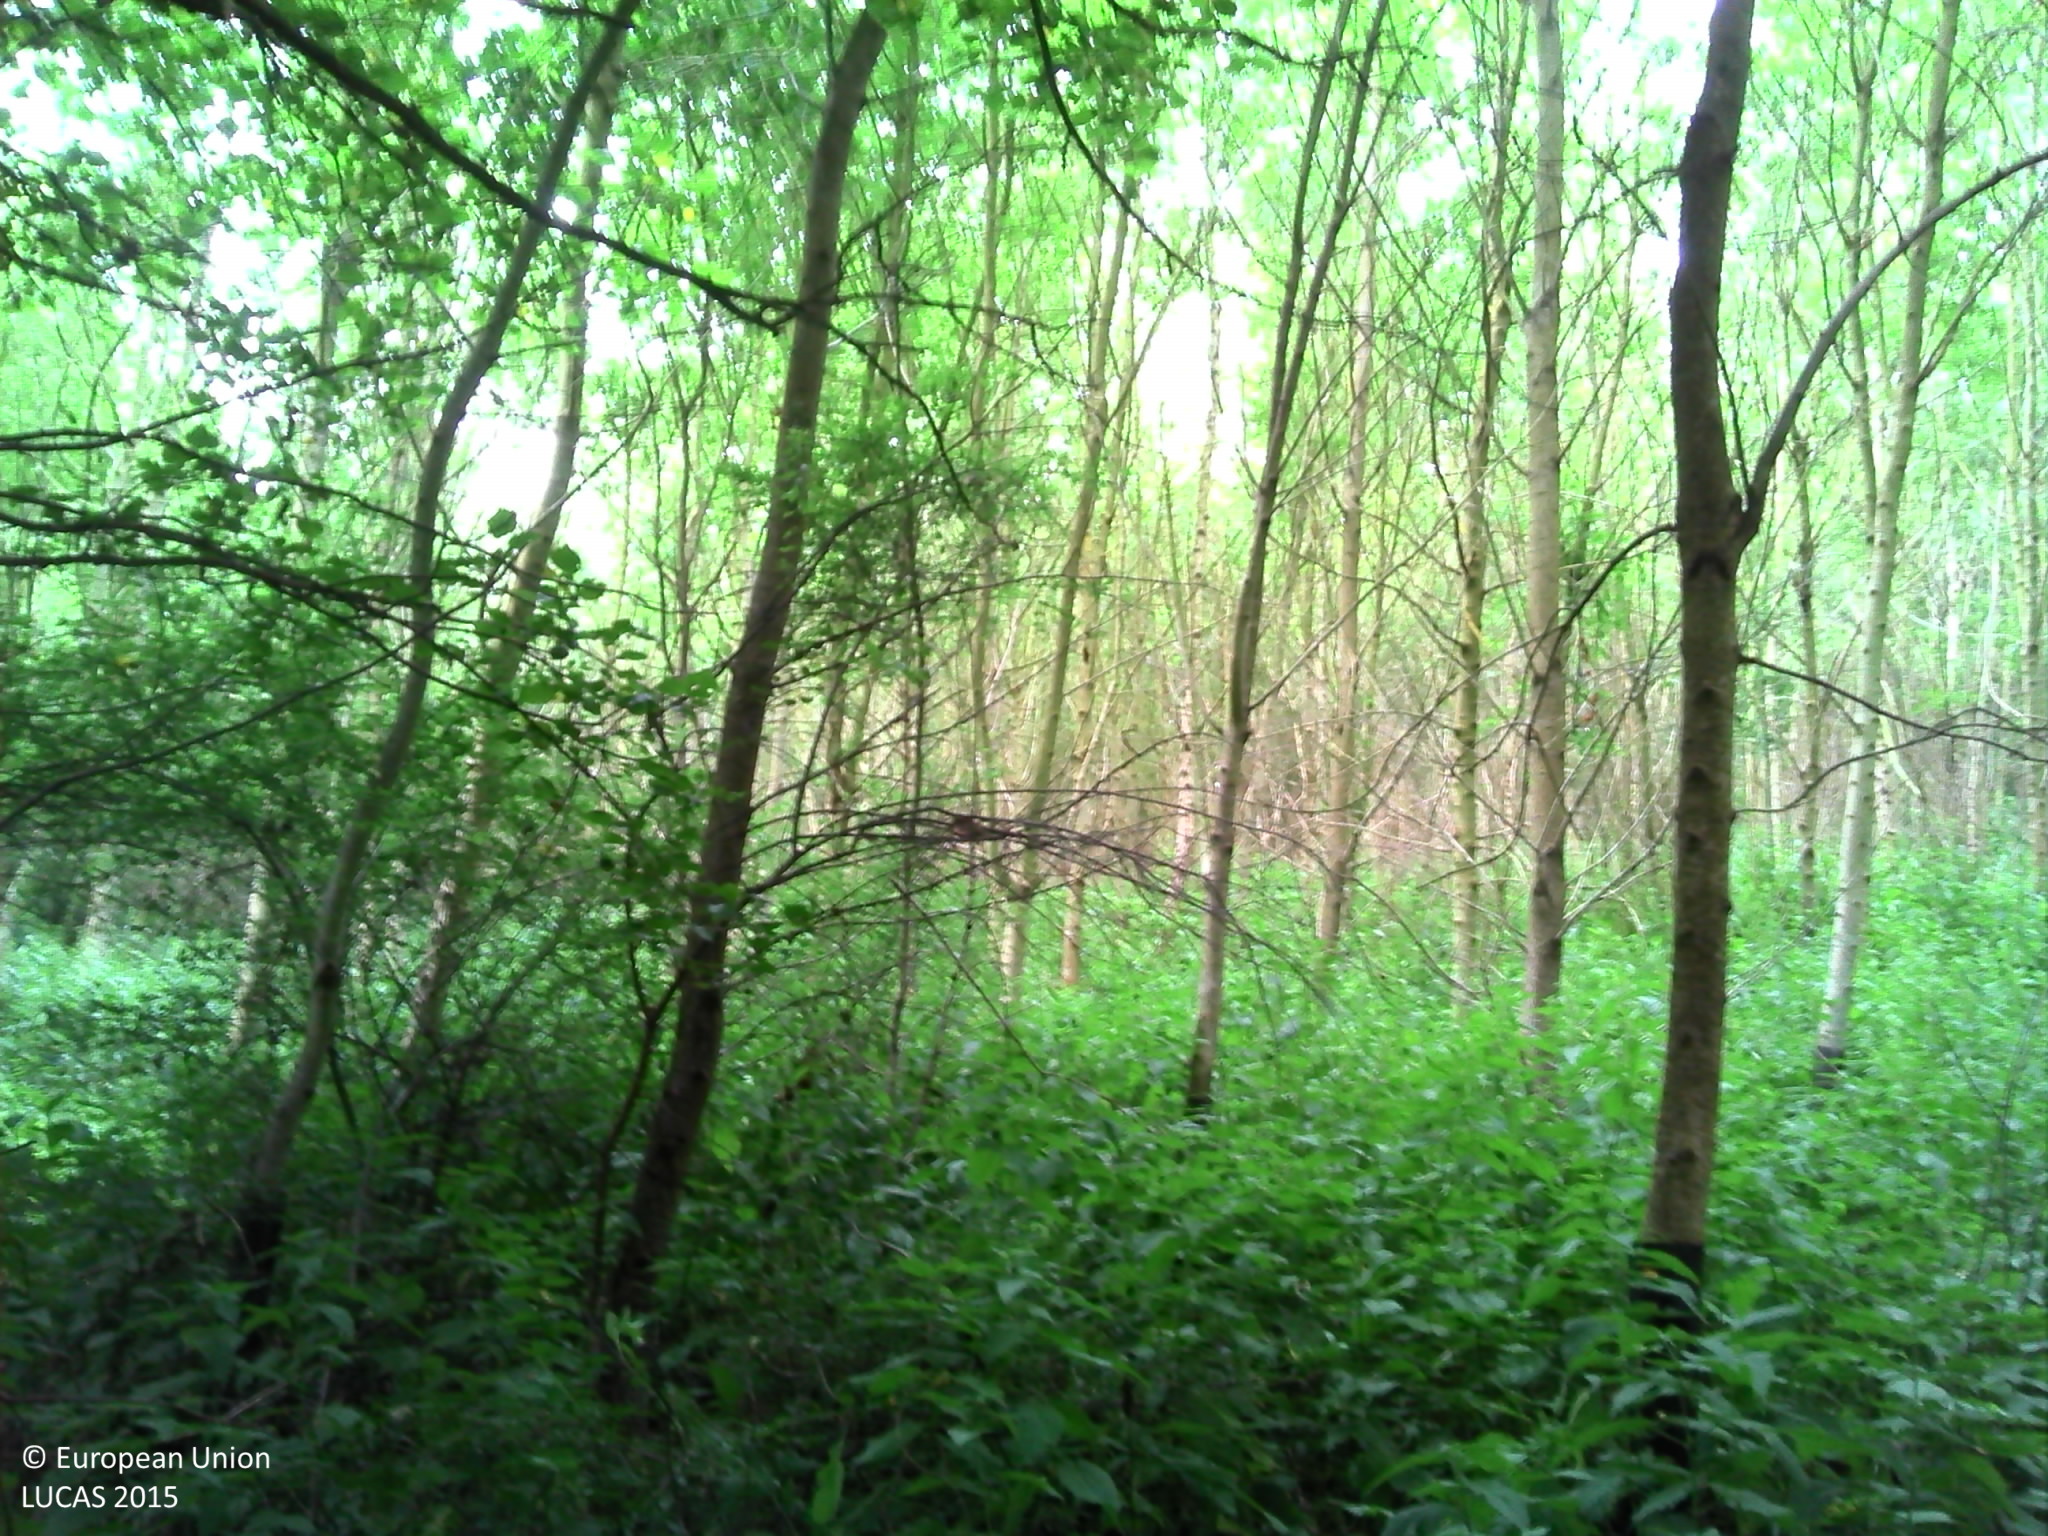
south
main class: Woodland
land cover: Broadleaved woodland
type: mesophytic deciduous forest
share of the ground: > 75 %
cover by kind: broadleaved forest trees 75 %, shrubs 15 %, herbaceous plants 10 %
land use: Forestry
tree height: > 5 m
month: July
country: FR
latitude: 49.4450
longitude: 1.9159
